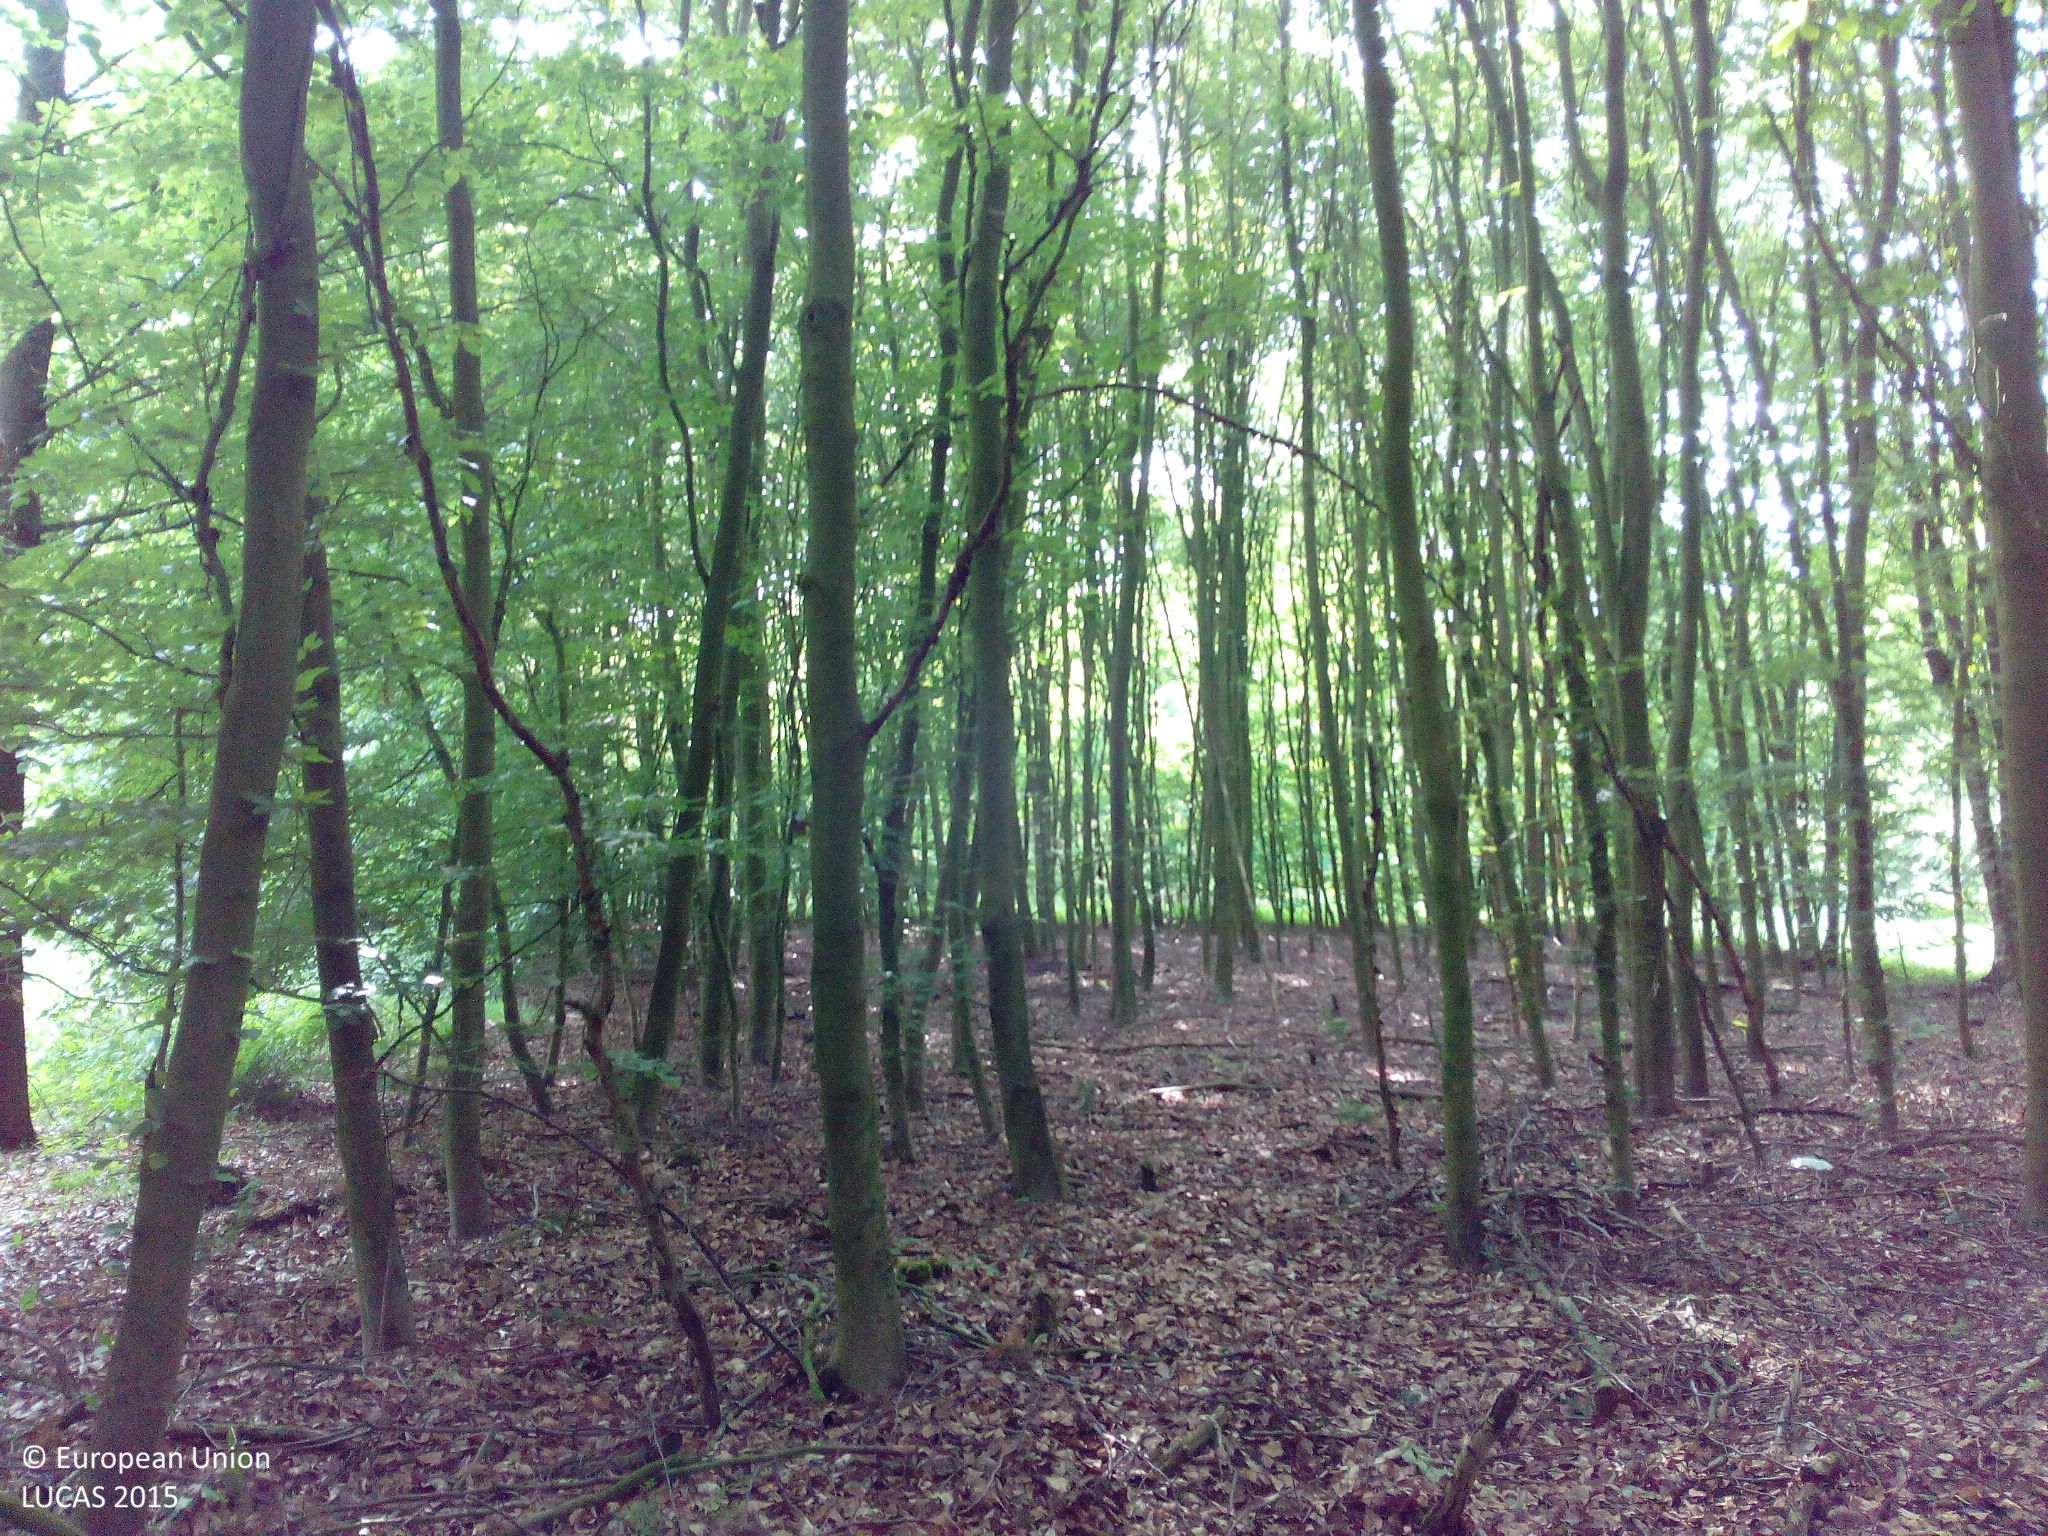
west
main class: Woodland
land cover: Broadleaved woodland
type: mesophytic deciduous forest
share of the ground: > 75 %
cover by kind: broadleaved forest trees 100 %
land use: Forestry
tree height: > 5 m
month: June
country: DE
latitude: 52.3324
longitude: 7.4616
